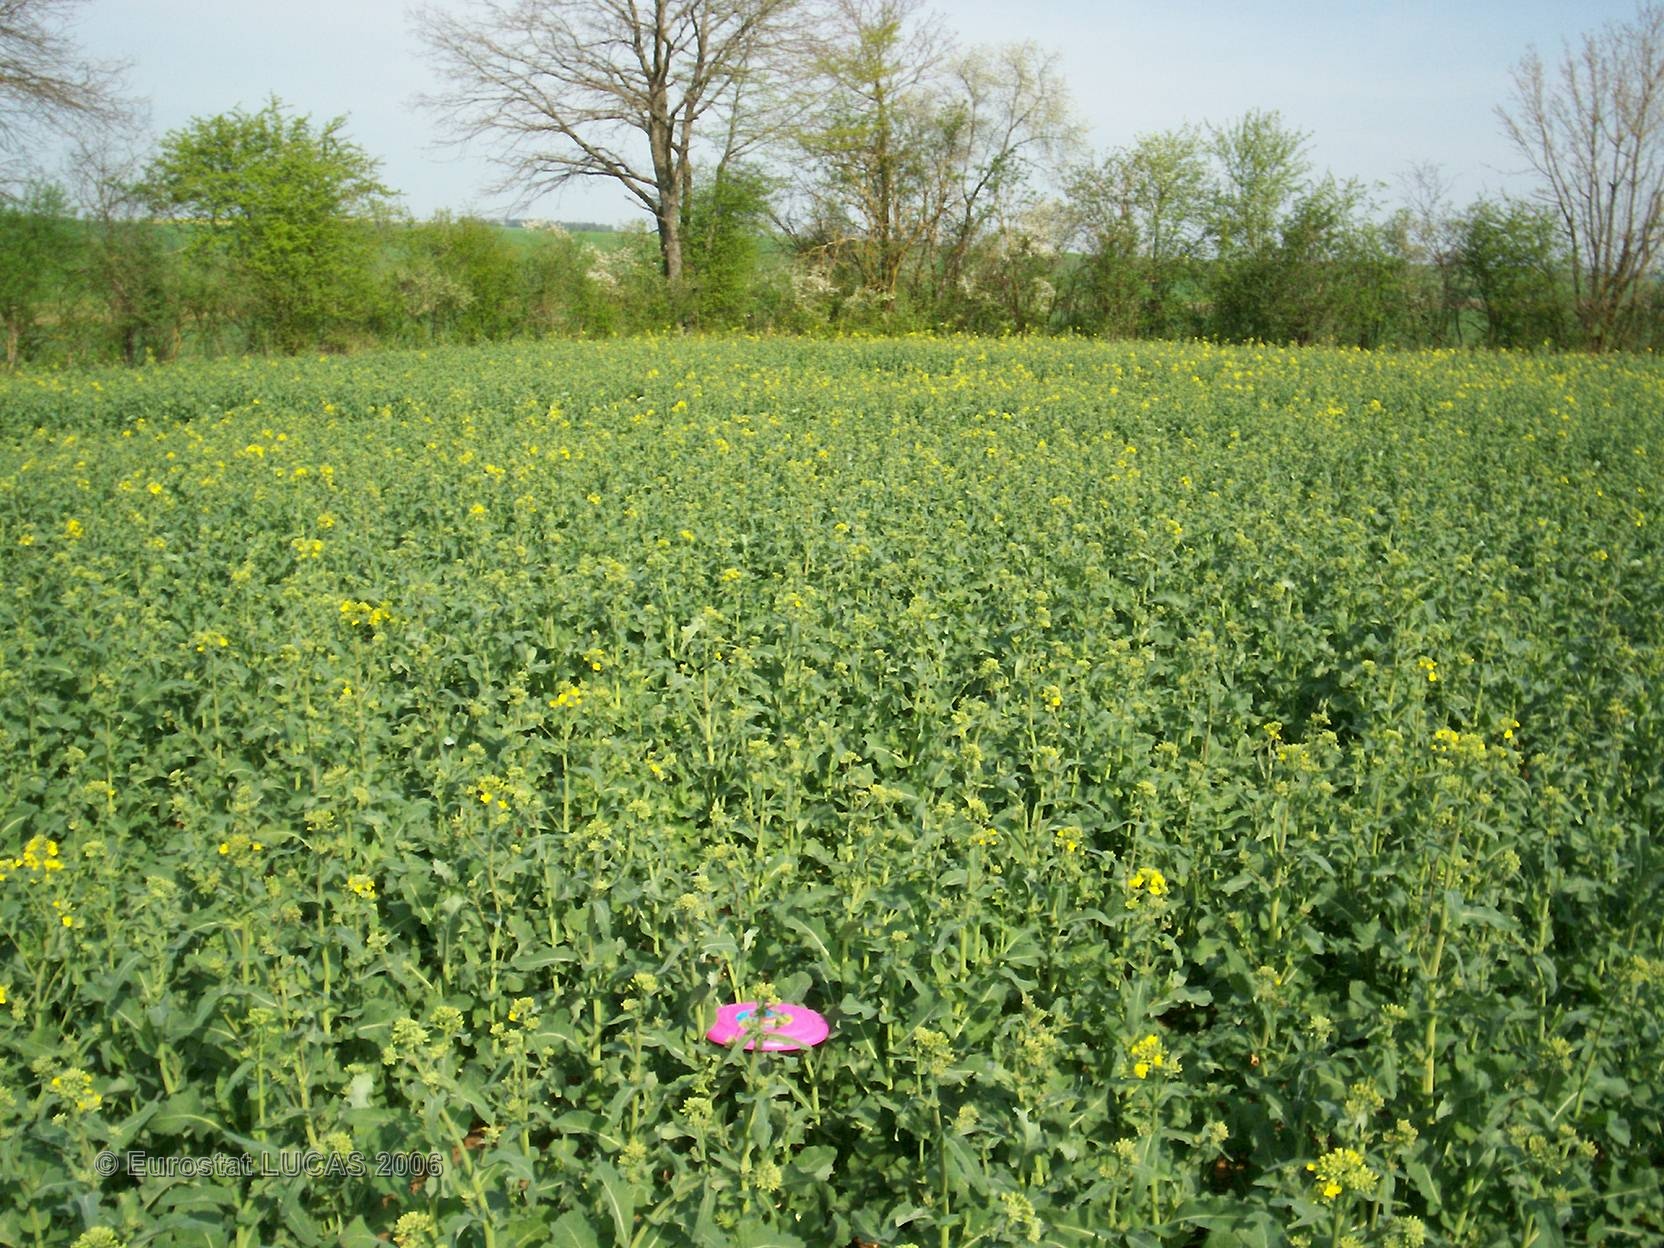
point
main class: Cropland
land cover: Rape and turnip rape
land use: Agriculture (excluding fallow land and kitchen gardens)
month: May
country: FR
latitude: 47.6035
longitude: 4.5854
